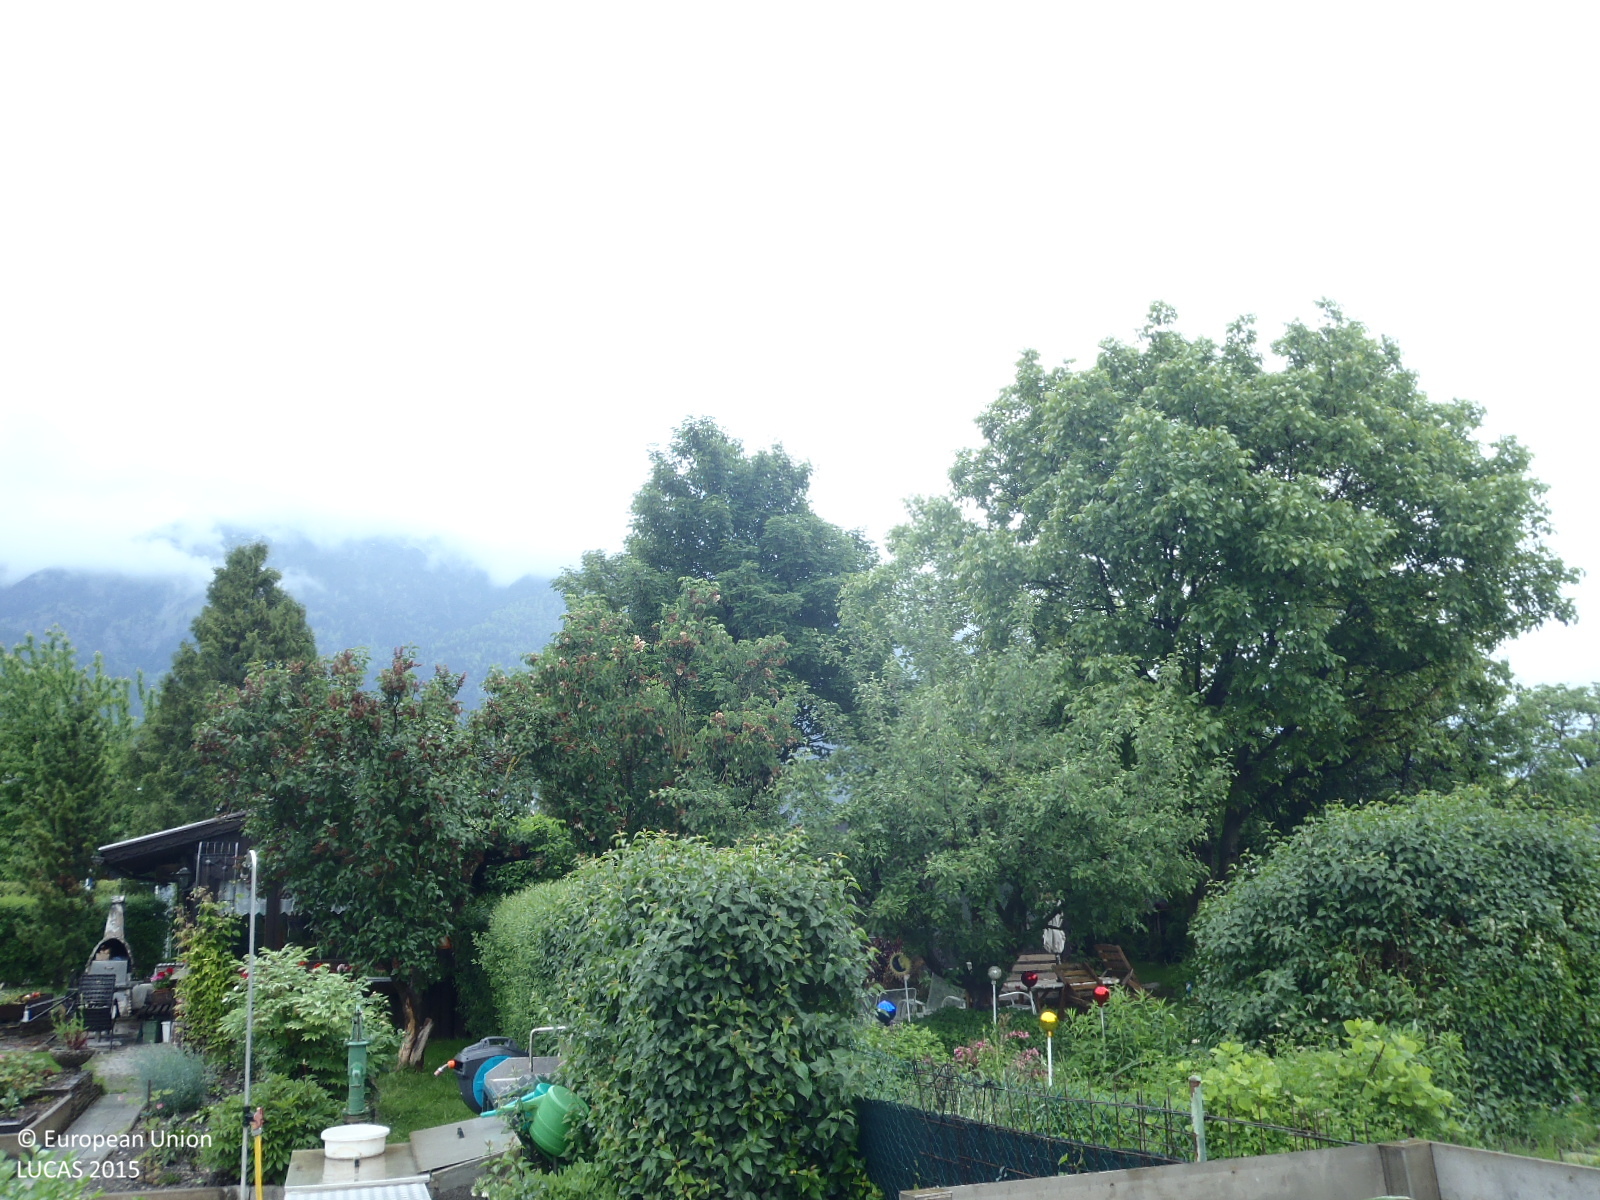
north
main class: Woodland
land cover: Broadleaved woodland
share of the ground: > 75 %
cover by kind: broadleaved forest trees 95 %, shrubs 5 %
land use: Residential
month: May
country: AT
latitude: 47.2777
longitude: 11.4661
